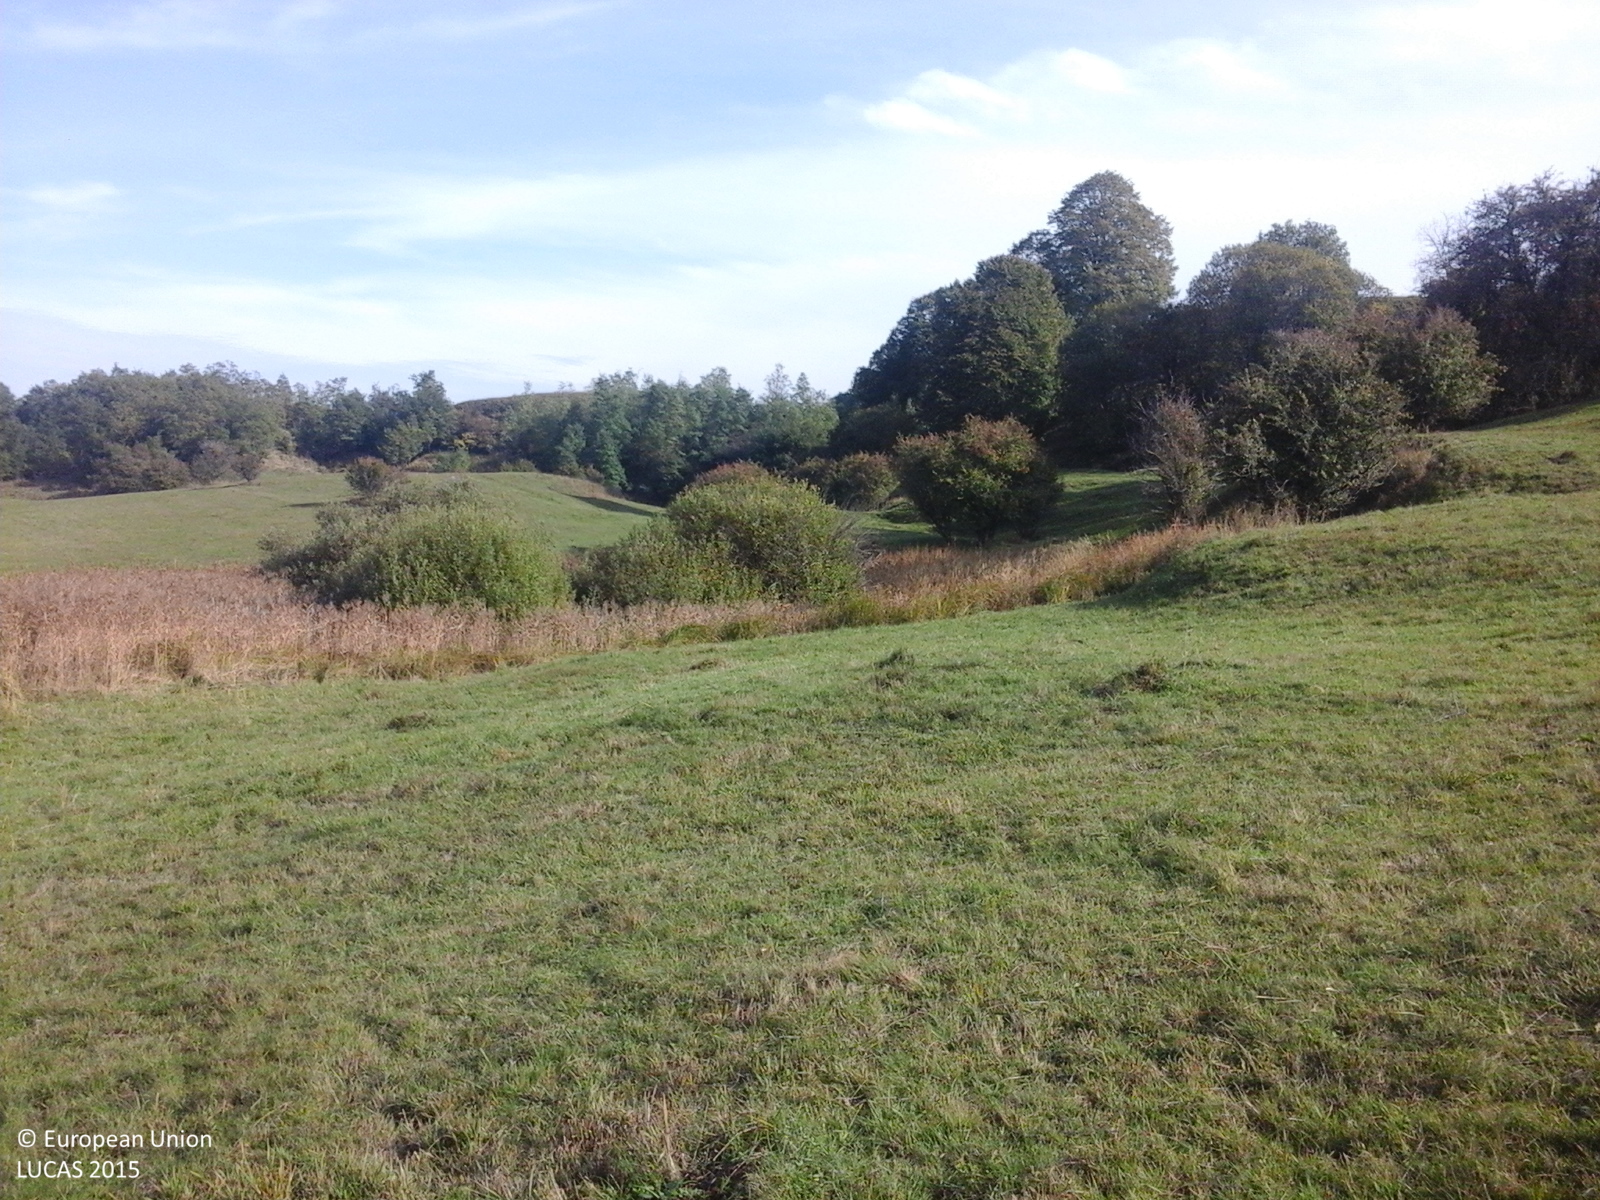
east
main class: Grassland
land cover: Grassland without tree/shrub cover
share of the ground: > 75 %
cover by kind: herbaceous plants 100 %
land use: Agriculture (excluding fallow land and kitchen gardens)
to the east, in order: Grassland without tree/shrub cover; Grassland with sparse tree/shrub cover; Inland marshes; Grassland without tree/shrub cover; Grassland with sparse tree/shrub cover; Broadleaved woodland
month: October
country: RO
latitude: 45.9497
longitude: 24.9672
